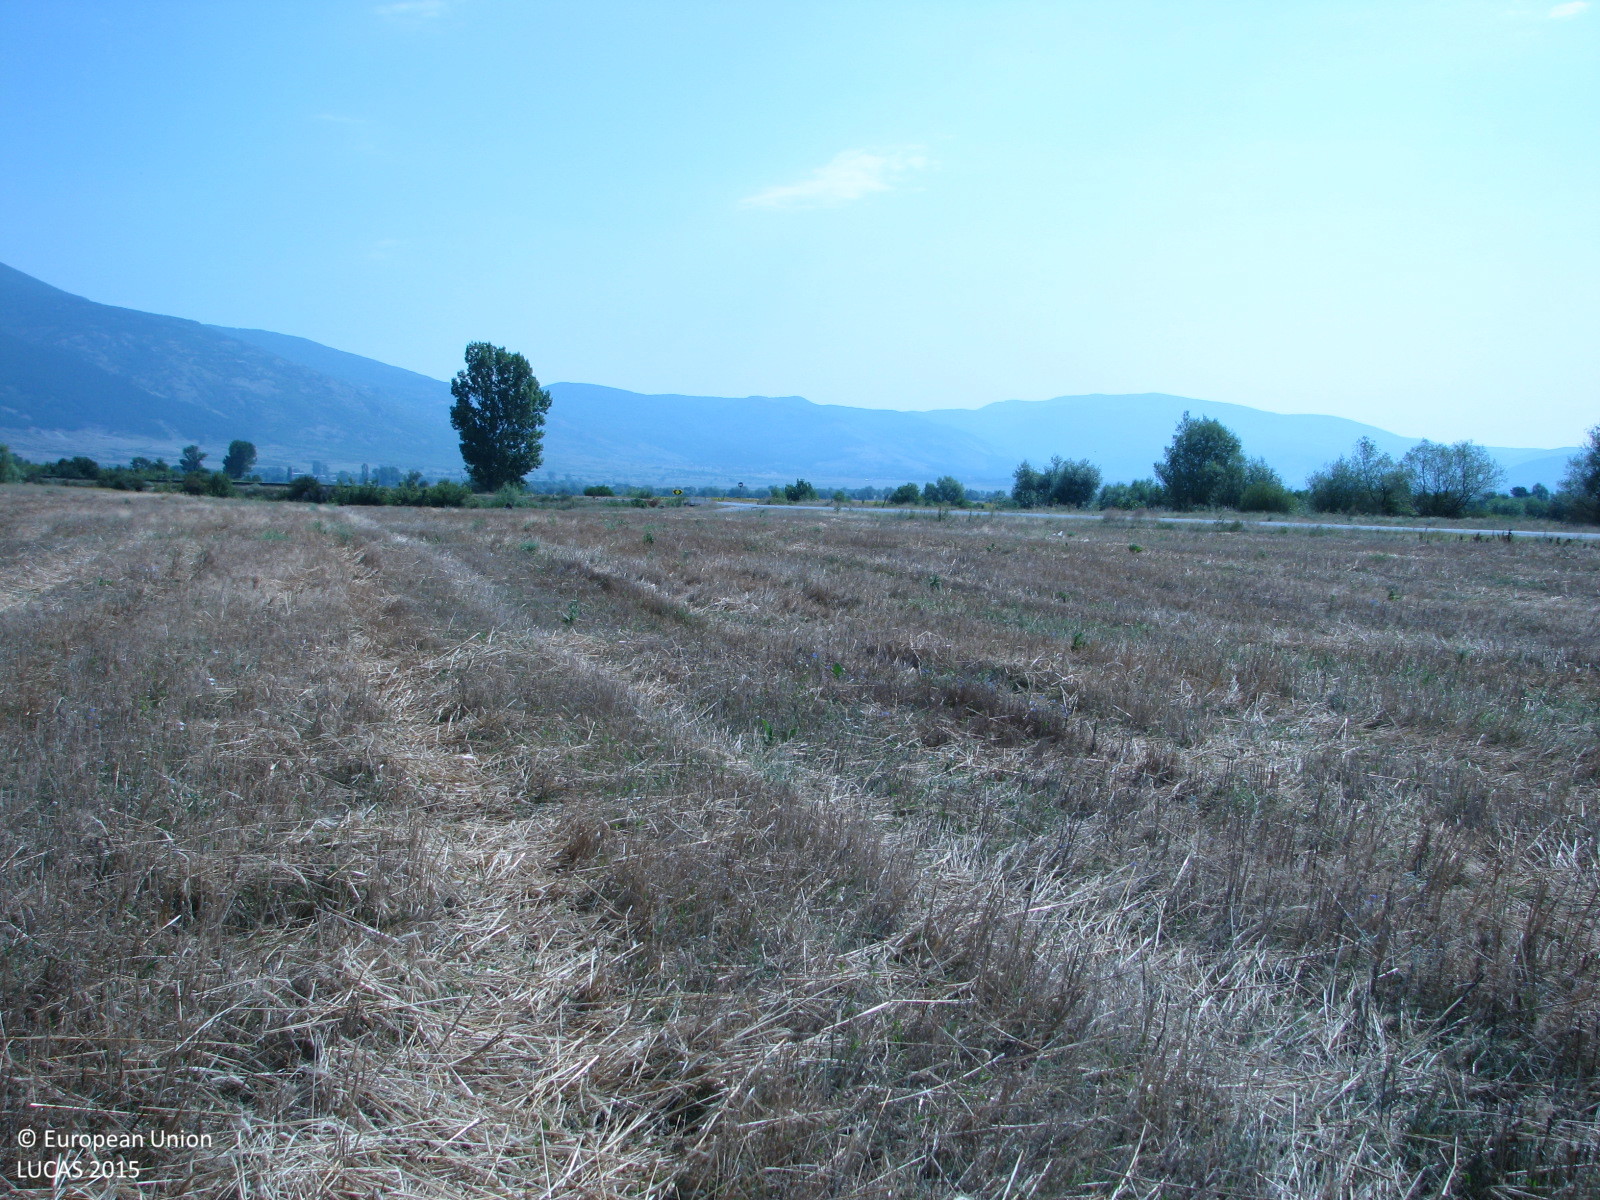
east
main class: Cropland
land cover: Rye
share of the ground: > 75 %
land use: Agriculture (excluding fallow land and kitchen gardens)
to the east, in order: Rye; Grass margins; Ditches and canals; Grass margins; Paved roads, cycling and walking lanes; Grass margins; Ditches and canals; Grassland without tree/shrub cover; Abandoned hedges; Ditches and canals; Grass margins; Common wheat; Grassland without tree/shrub cover
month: July
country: BG
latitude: 42.6657
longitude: 25.9551
